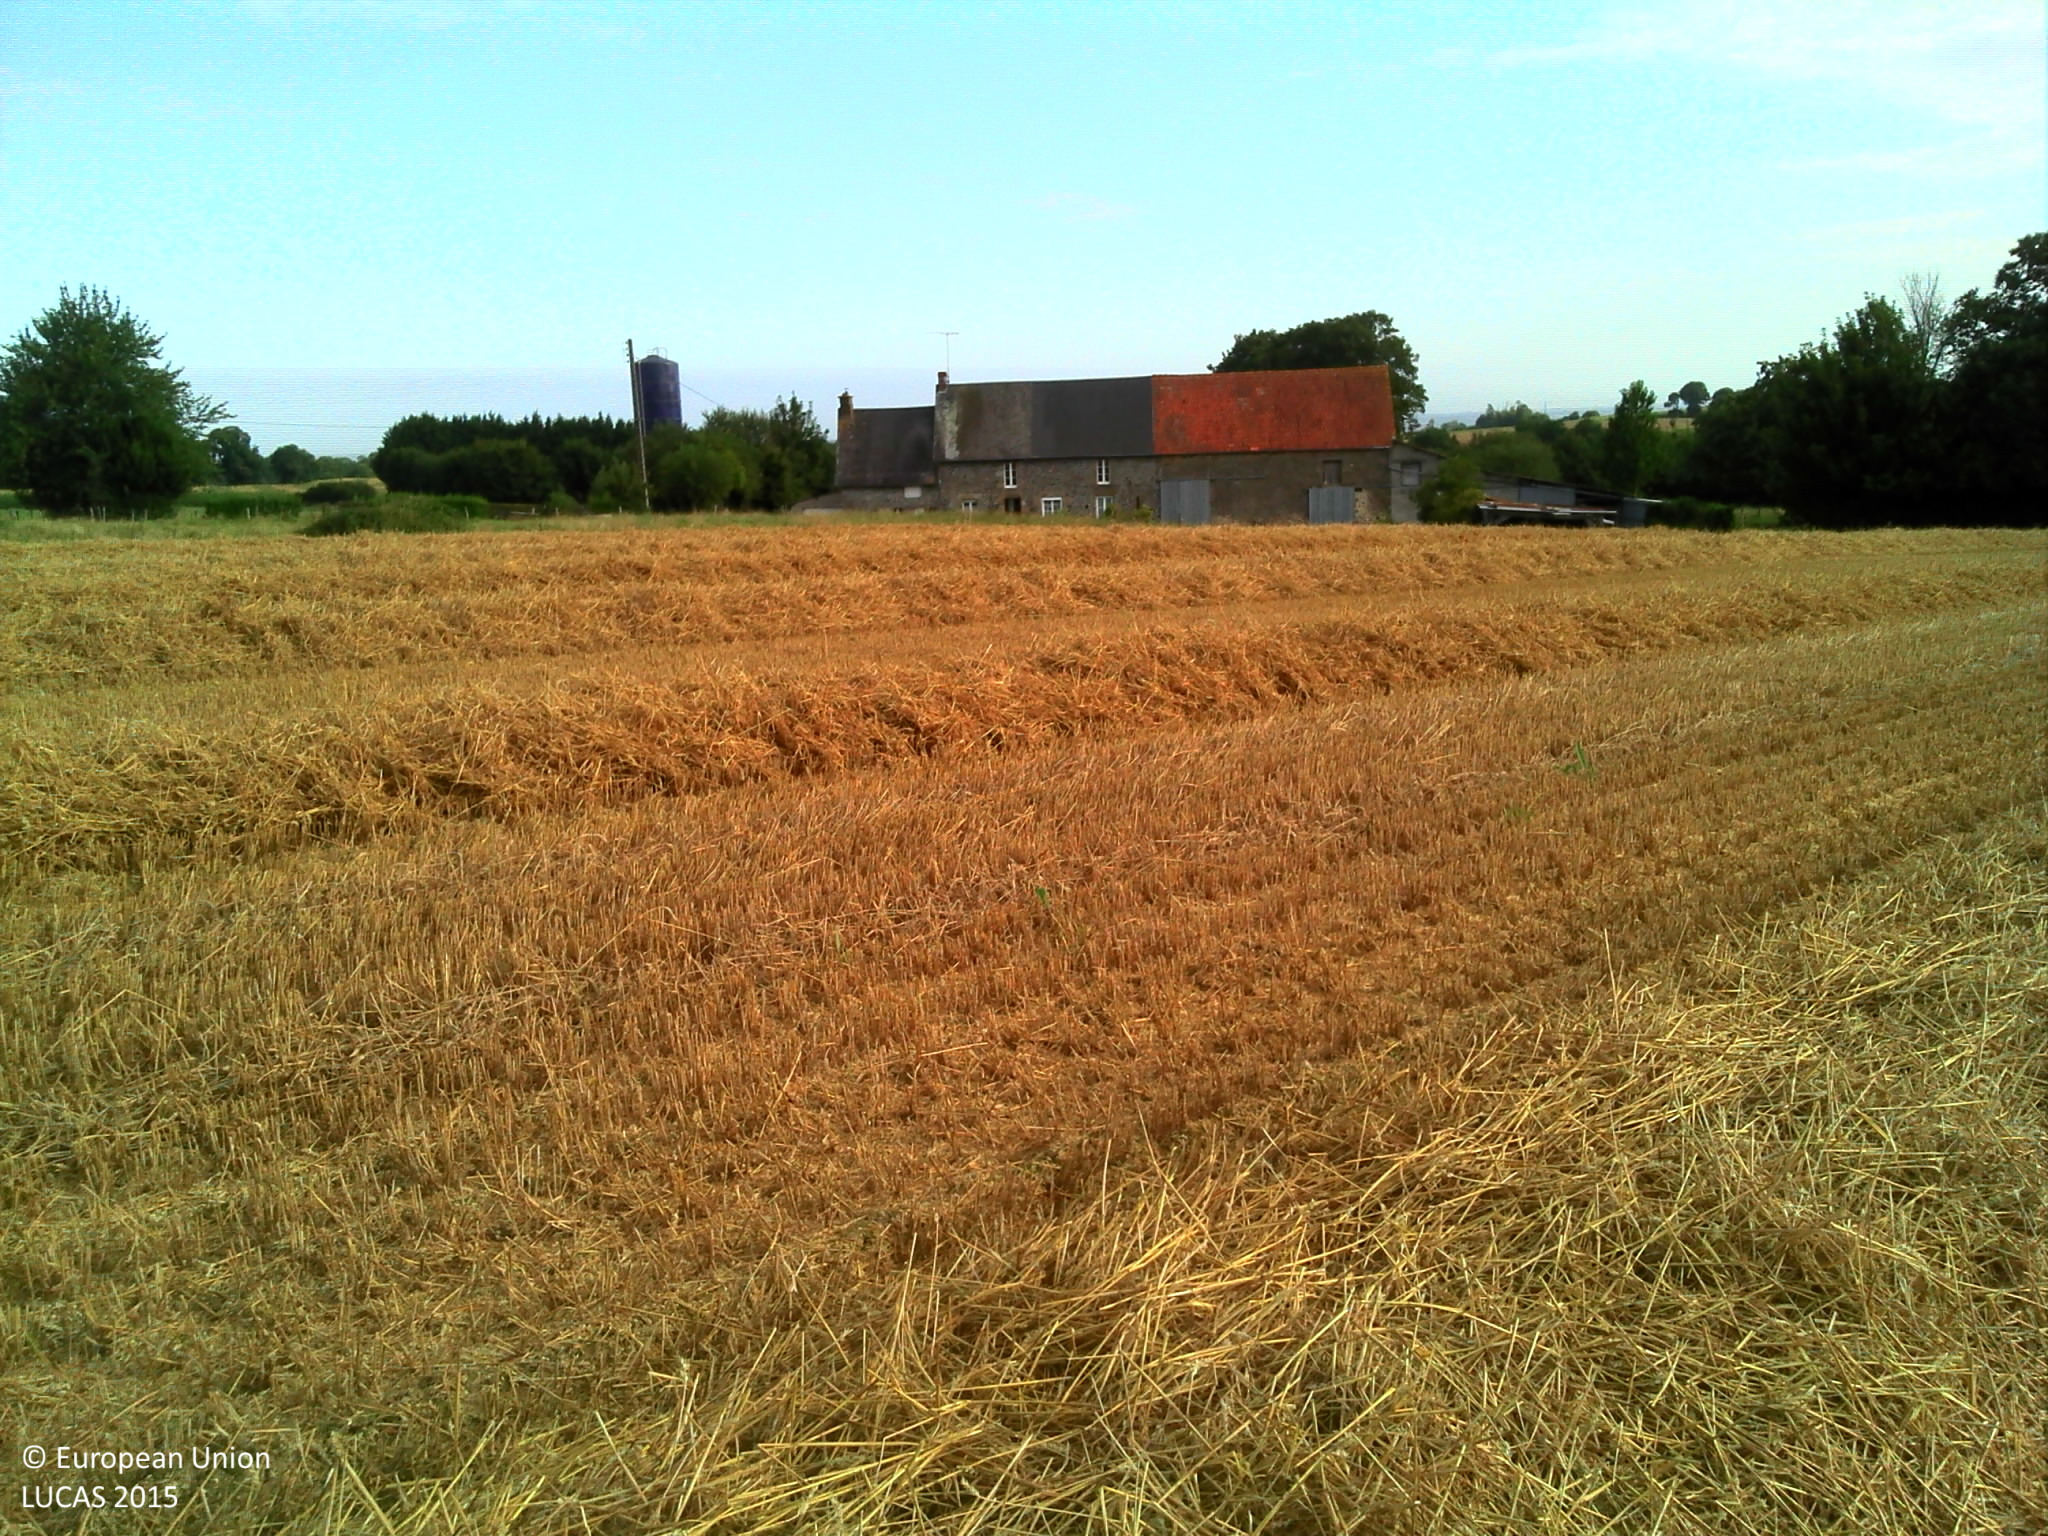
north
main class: Cropland
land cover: Common wheat
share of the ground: > 75 %
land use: Agriculture (excluding fallow land and kitchen gardens)
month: August
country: FR
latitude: 48.5309
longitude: -1.2978
